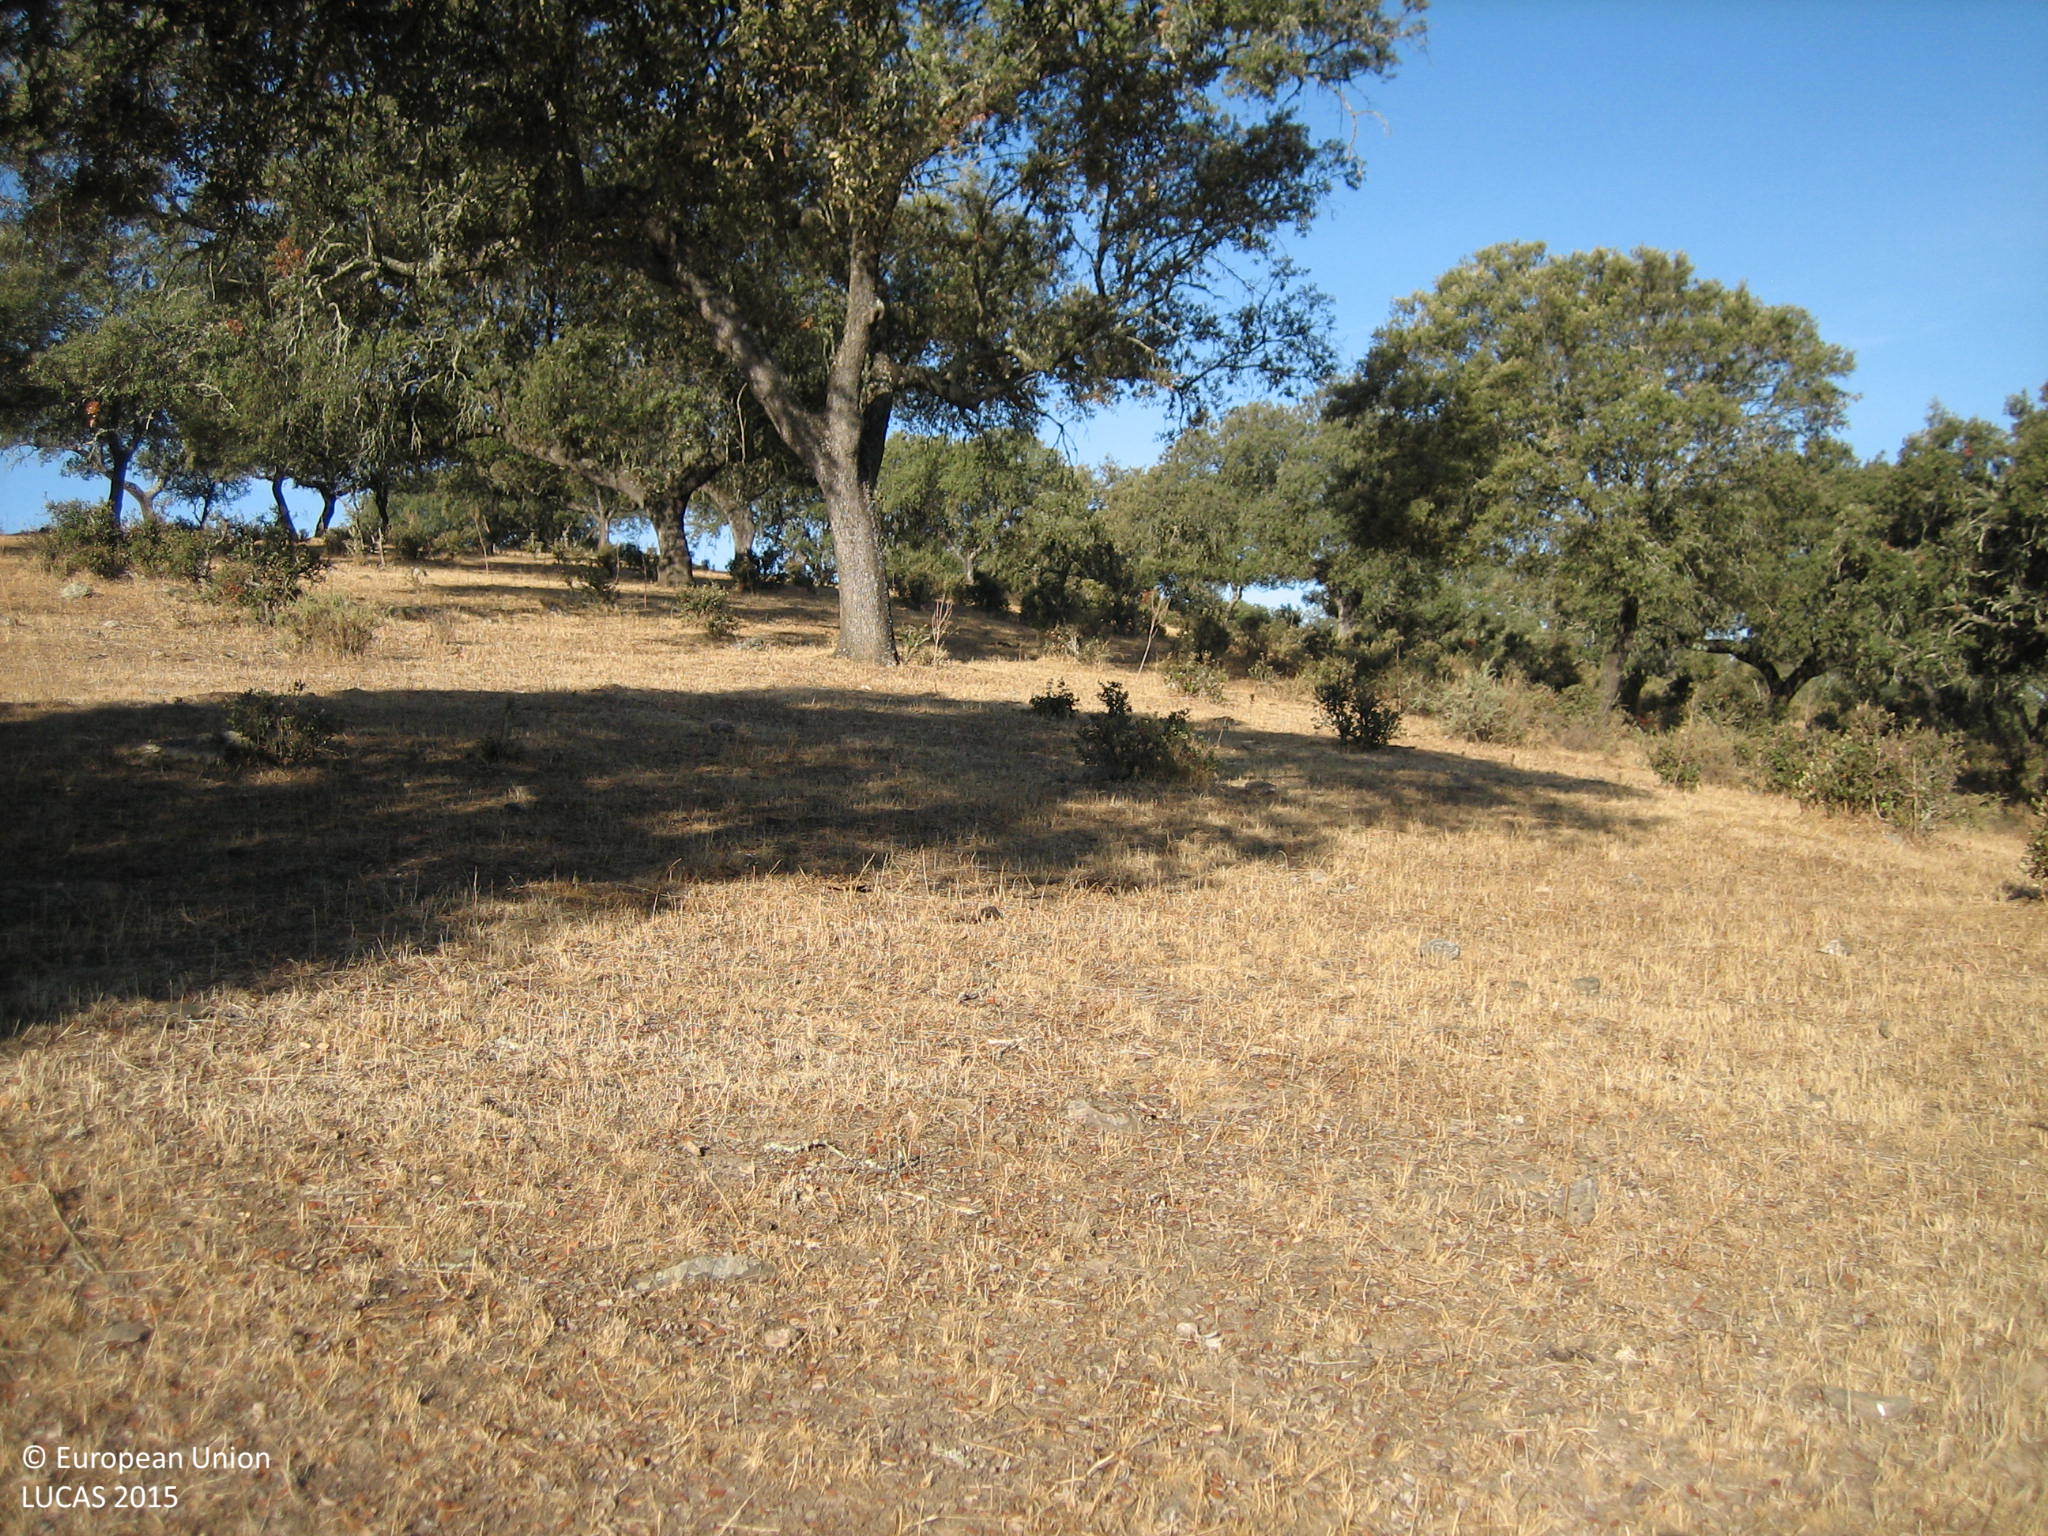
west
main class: Woodland
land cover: Broadleaved woodland
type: broadleaved evergreen forest
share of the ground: 25 - 50 %
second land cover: Grassland without tree/shrub cover
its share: 25 - 50 %
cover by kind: broadleaved forest trees 40 %, herbaceous plants 30 %, unconsolidated bare surface 30 %
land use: Forestry
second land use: Agriculture (excluding fallow land and kitchen gardens)
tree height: > 5 m
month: August
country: ES
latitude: 38.5725
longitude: -7.1823
